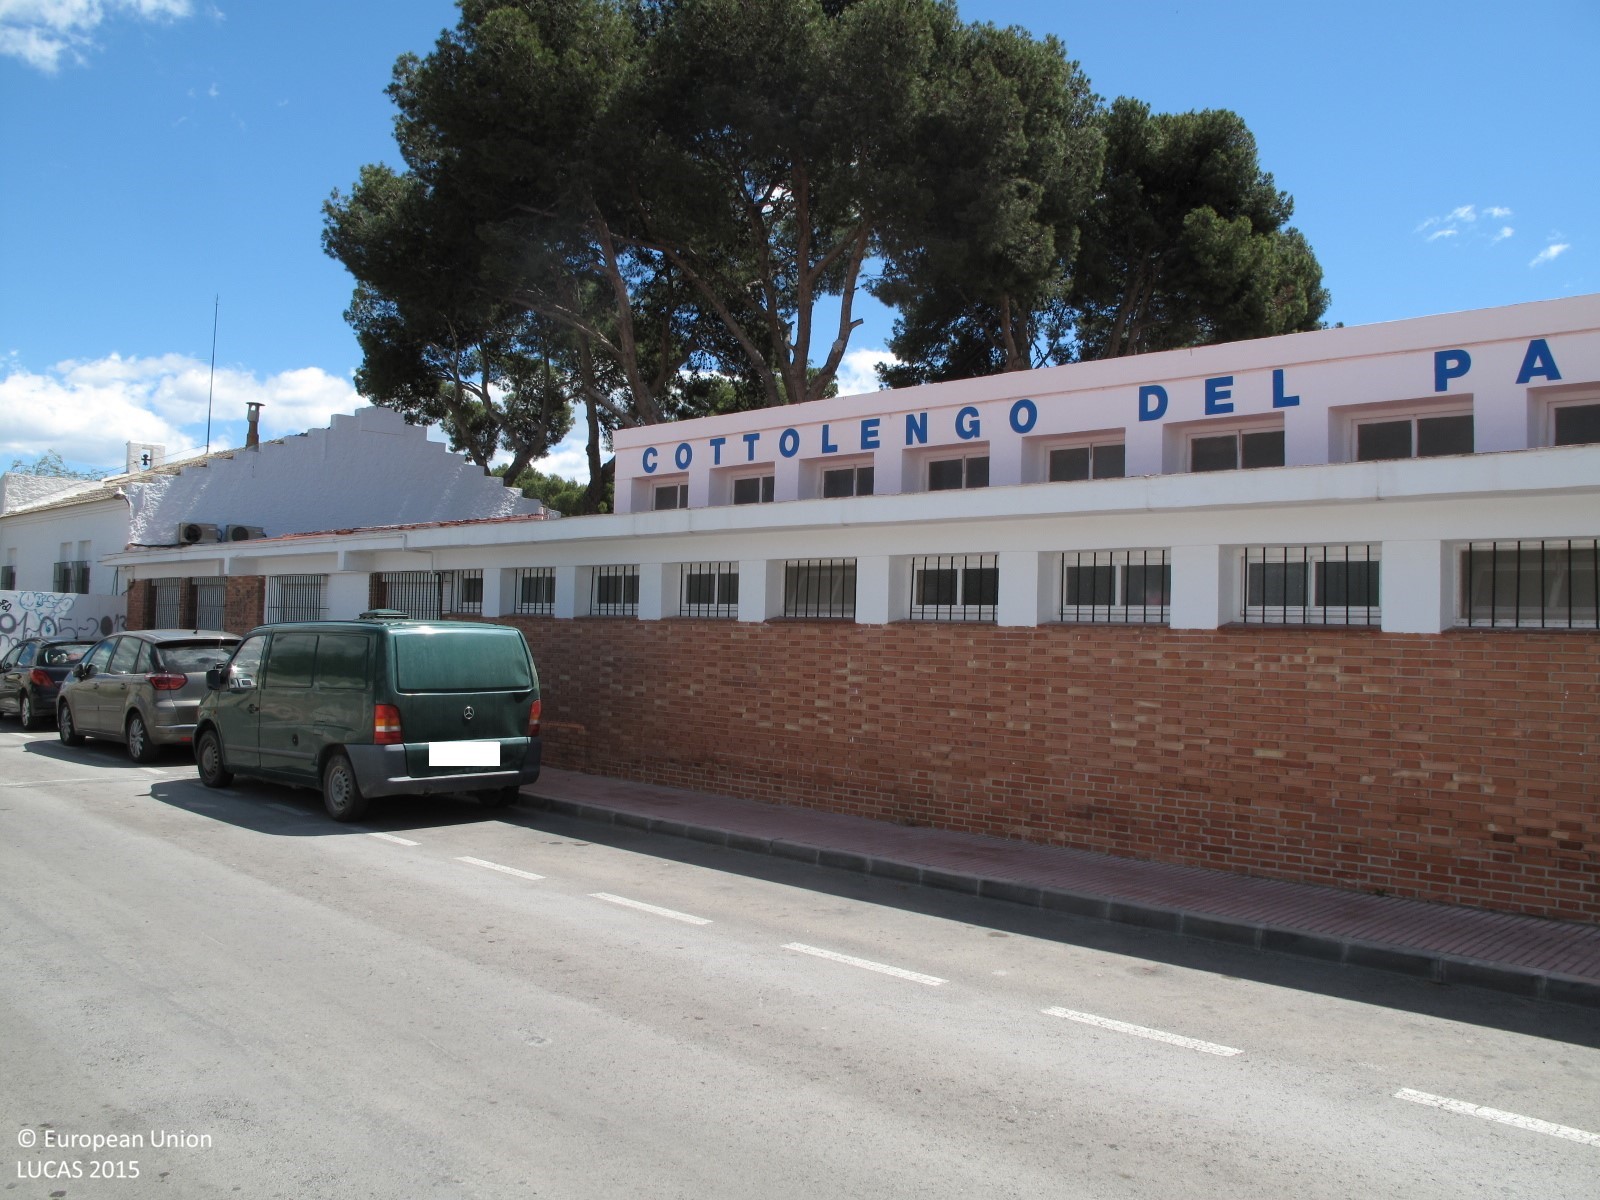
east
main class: Cropland
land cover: Oranges
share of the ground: < 10 %
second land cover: Other bare soil
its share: > 75 %
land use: Kitchen garden
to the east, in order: Oranges; Other bare soil; Artificial constructions in urban areas
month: April
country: ES
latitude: 38.3878
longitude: -0.5073
